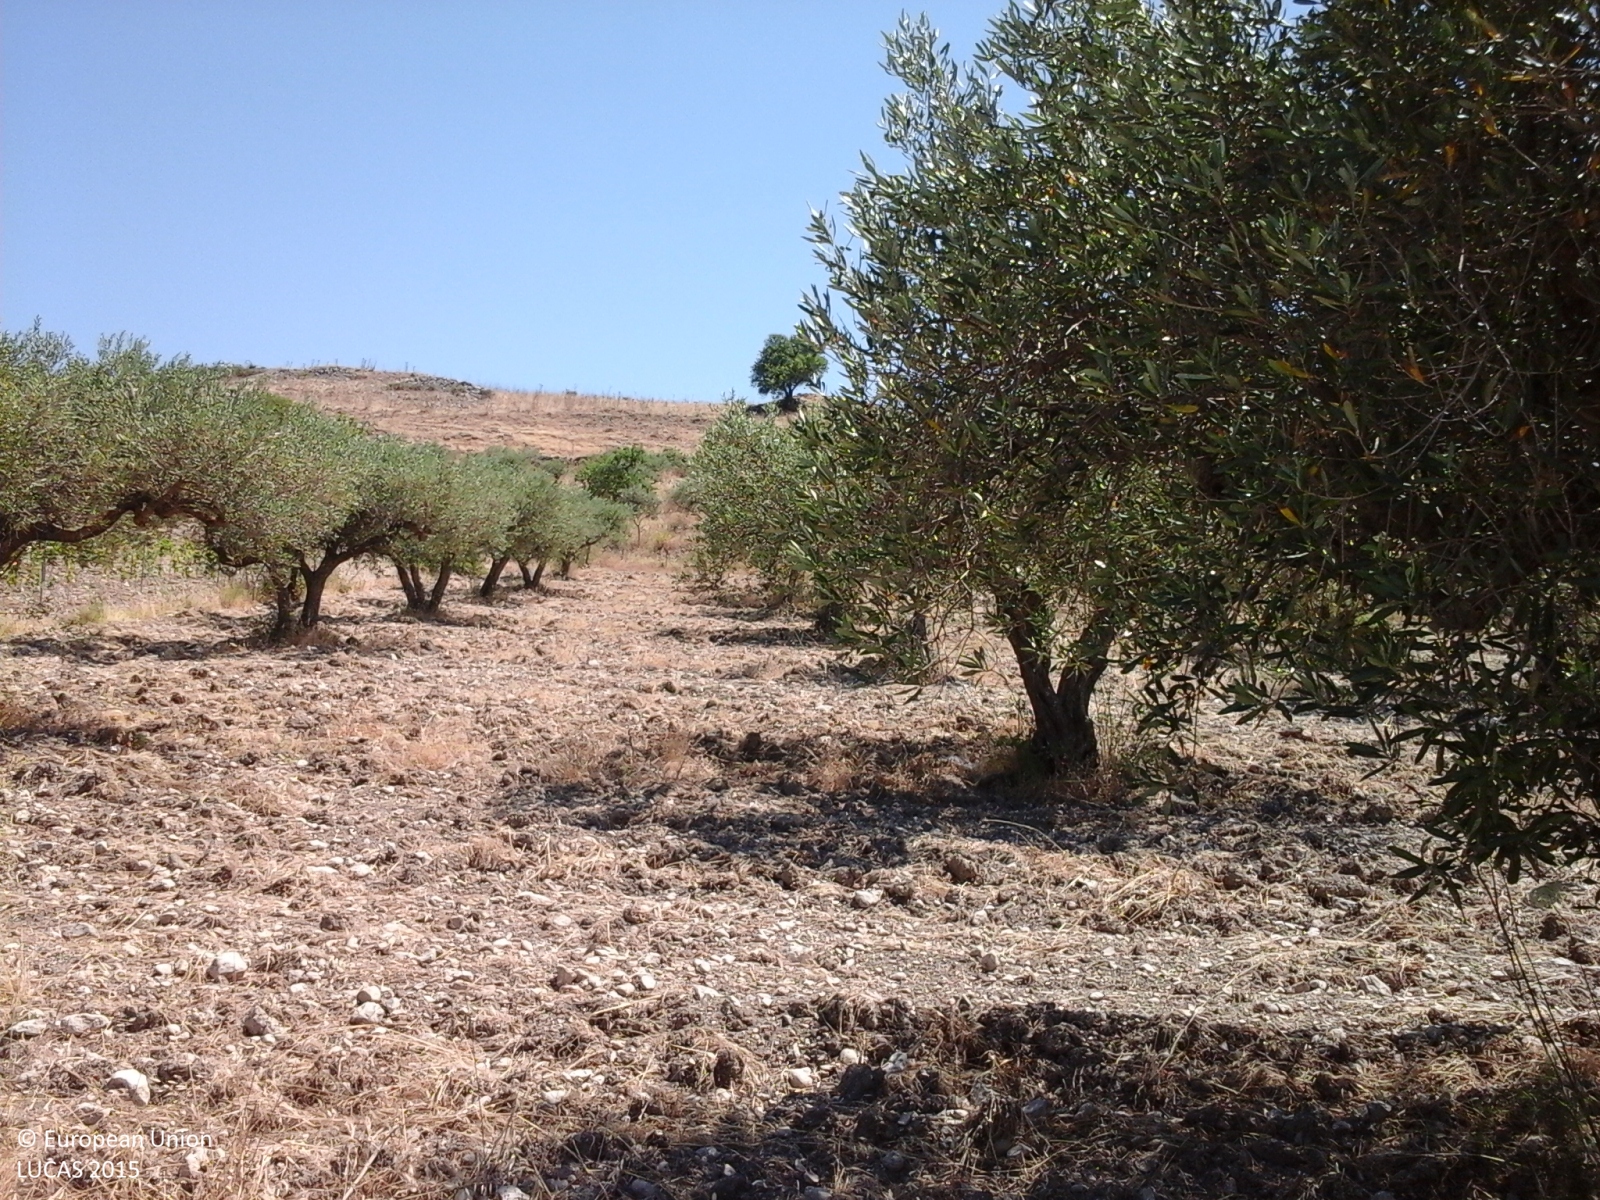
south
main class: Cropland
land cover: Olive groves
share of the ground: 50 - 75 %
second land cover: Other bare soil
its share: > 75 %
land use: Agriculture (excluding fallow land and kitchen gardens)
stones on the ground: < 10 %
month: June
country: IT
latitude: 37.6405
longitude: 13.1607
